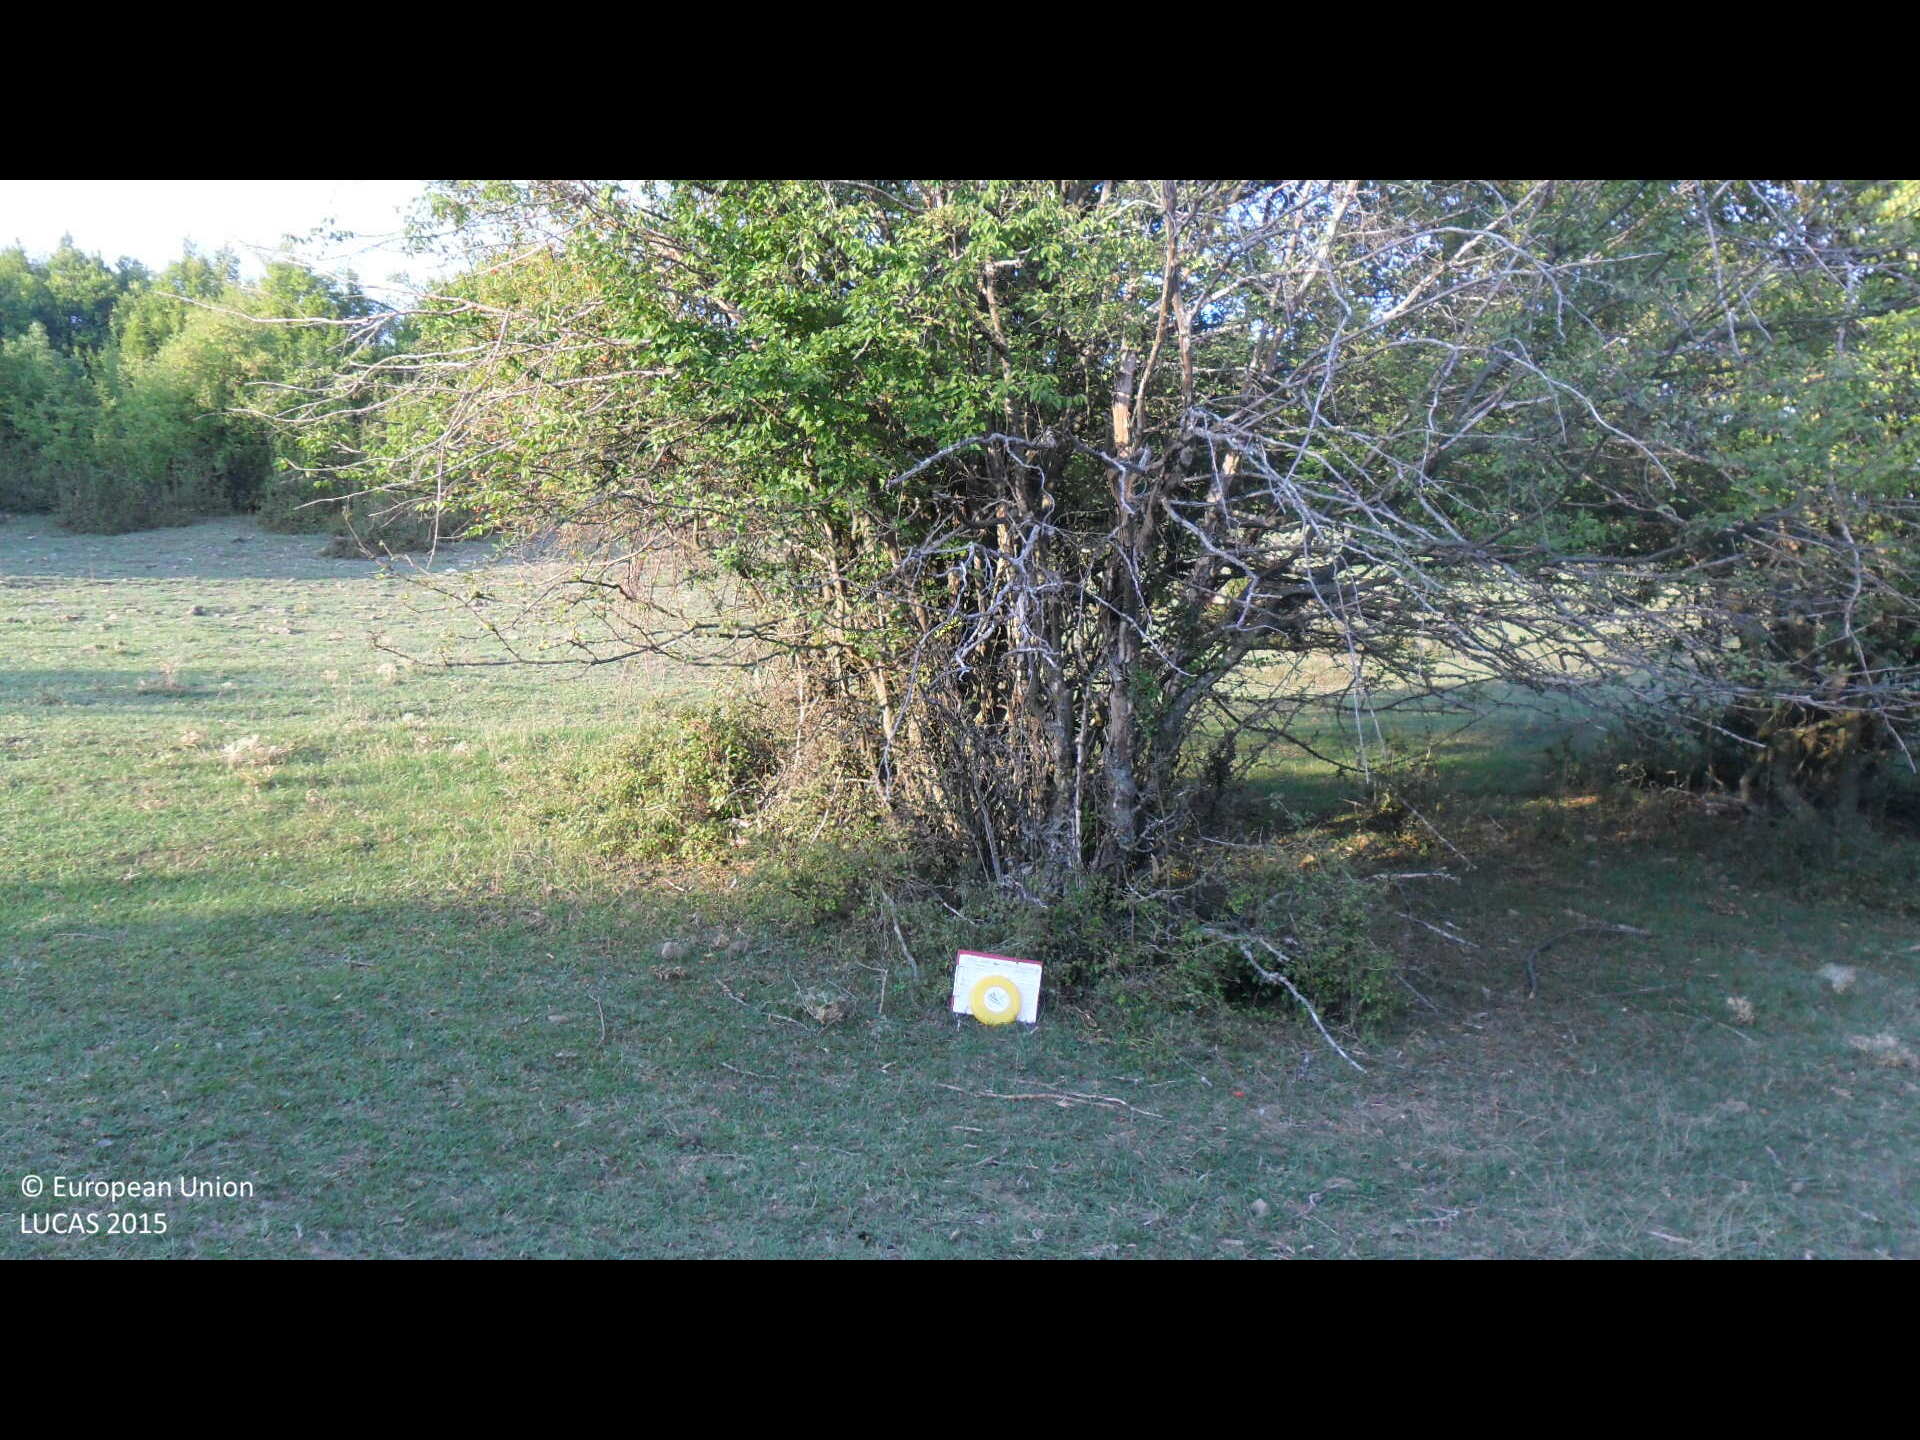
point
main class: Shrubland
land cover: Shrubland with sparse tree cover
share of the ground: 50 - 75 %
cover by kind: shrubs 70 %, herbaceous plants 25 %, broadleaved forest trees 5 %
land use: Agriculture (excluding fallow land and kitchen gardens)
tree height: < 5 m
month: September
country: BG
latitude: 43.0762
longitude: 26.5966
